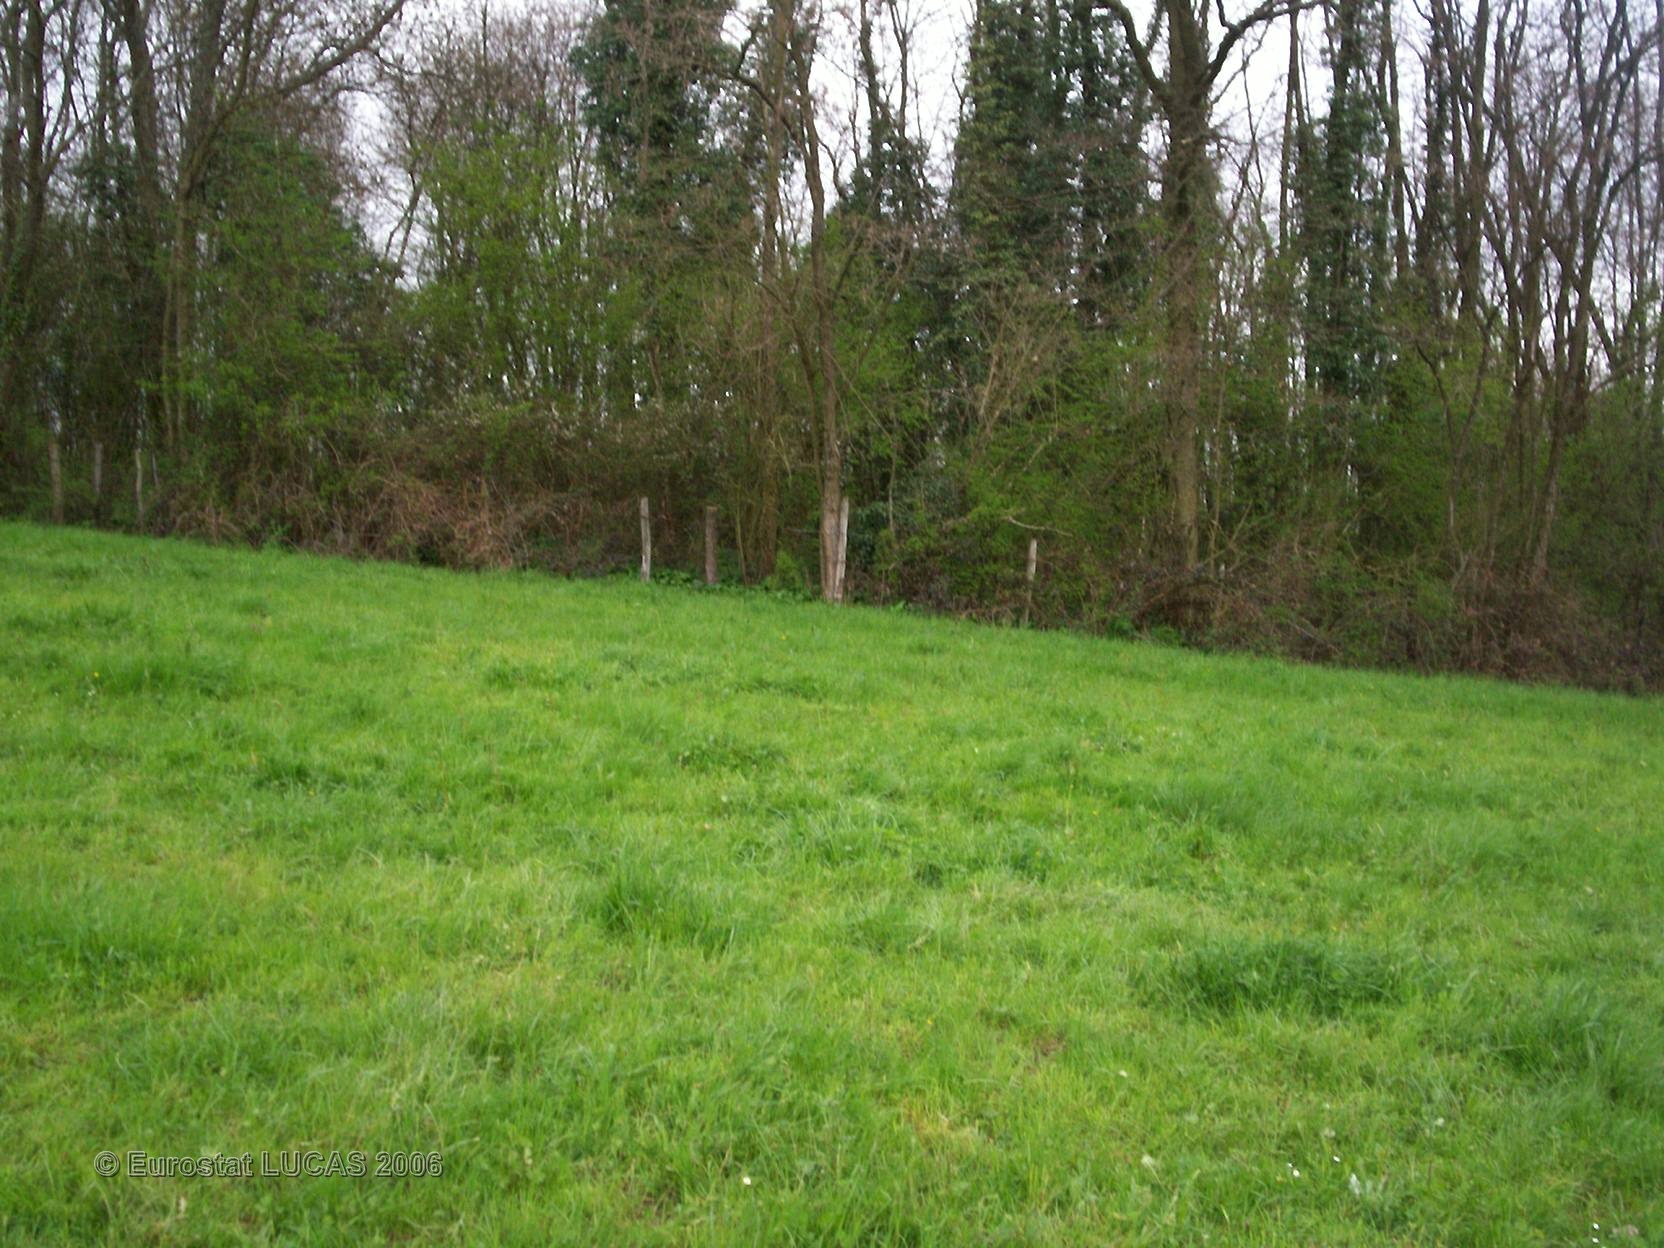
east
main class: Grassland
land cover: Grassland without tree/shrub cover
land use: Agriculture (excluding fallow land and kitchen gardens)
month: April
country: FR
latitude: 46.2416
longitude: 4.7759
